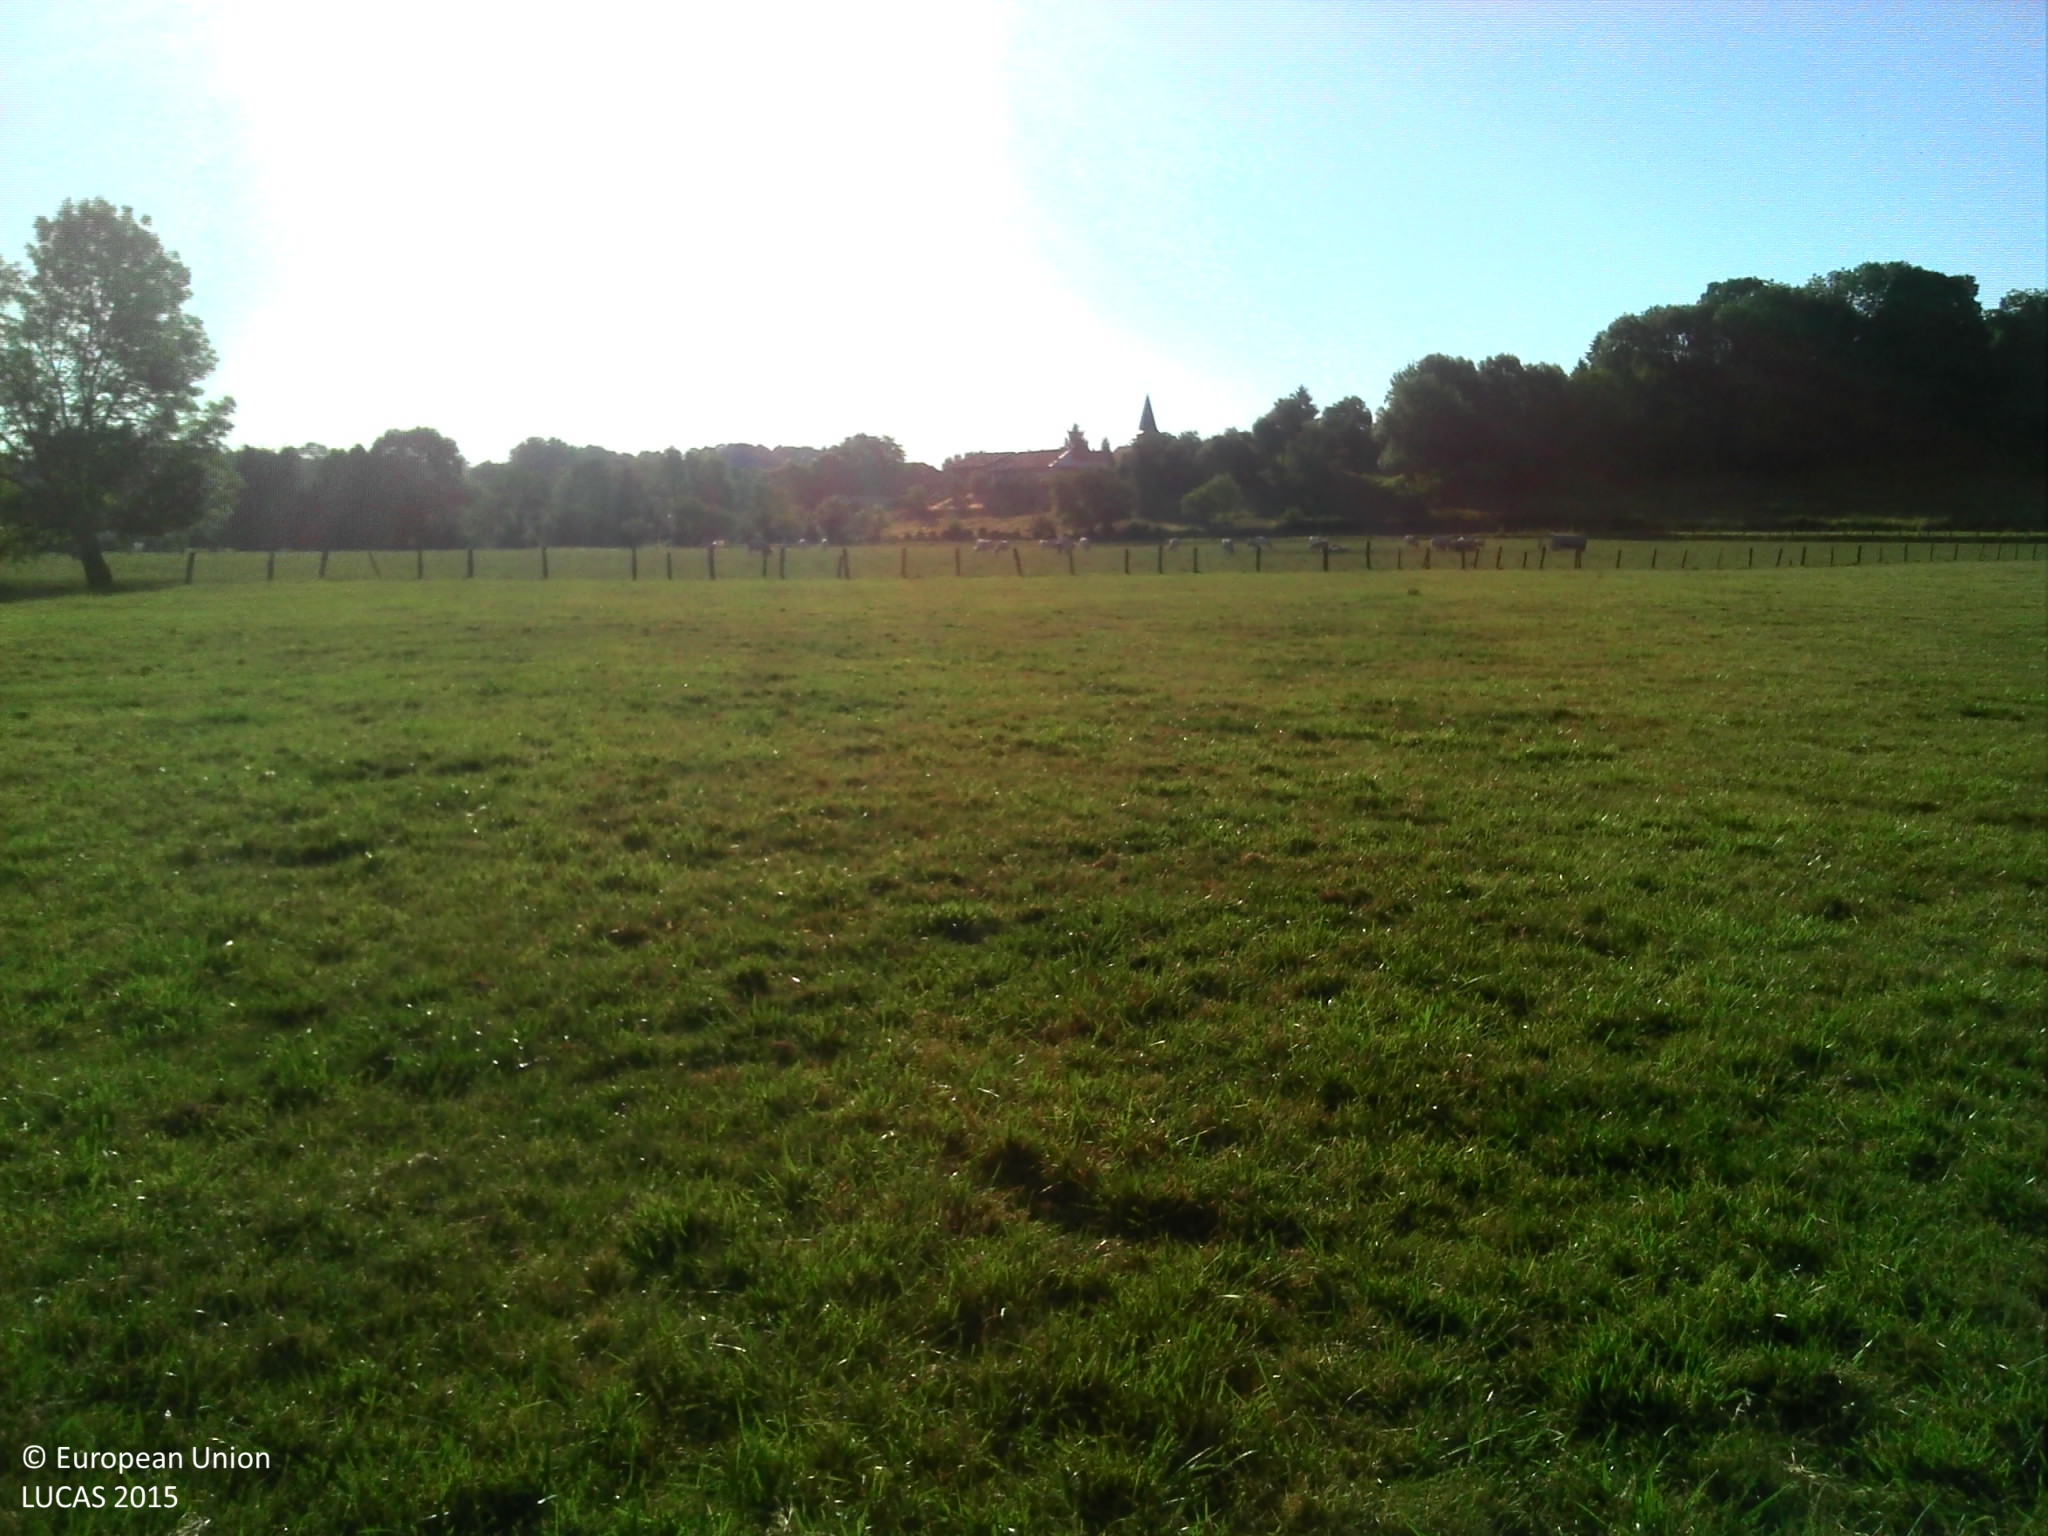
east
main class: Grassland
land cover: Grassland without tree/shrub cover
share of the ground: > 75 %
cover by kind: herbaceous plants 100 %
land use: Agriculture (excluding fallow land and kitchen gardens)
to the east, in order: Grassland without tree/shrub cover; Fences; Grassland without tree/shrub cover
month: July
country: FR
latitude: 48.8837
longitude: 4.9658
